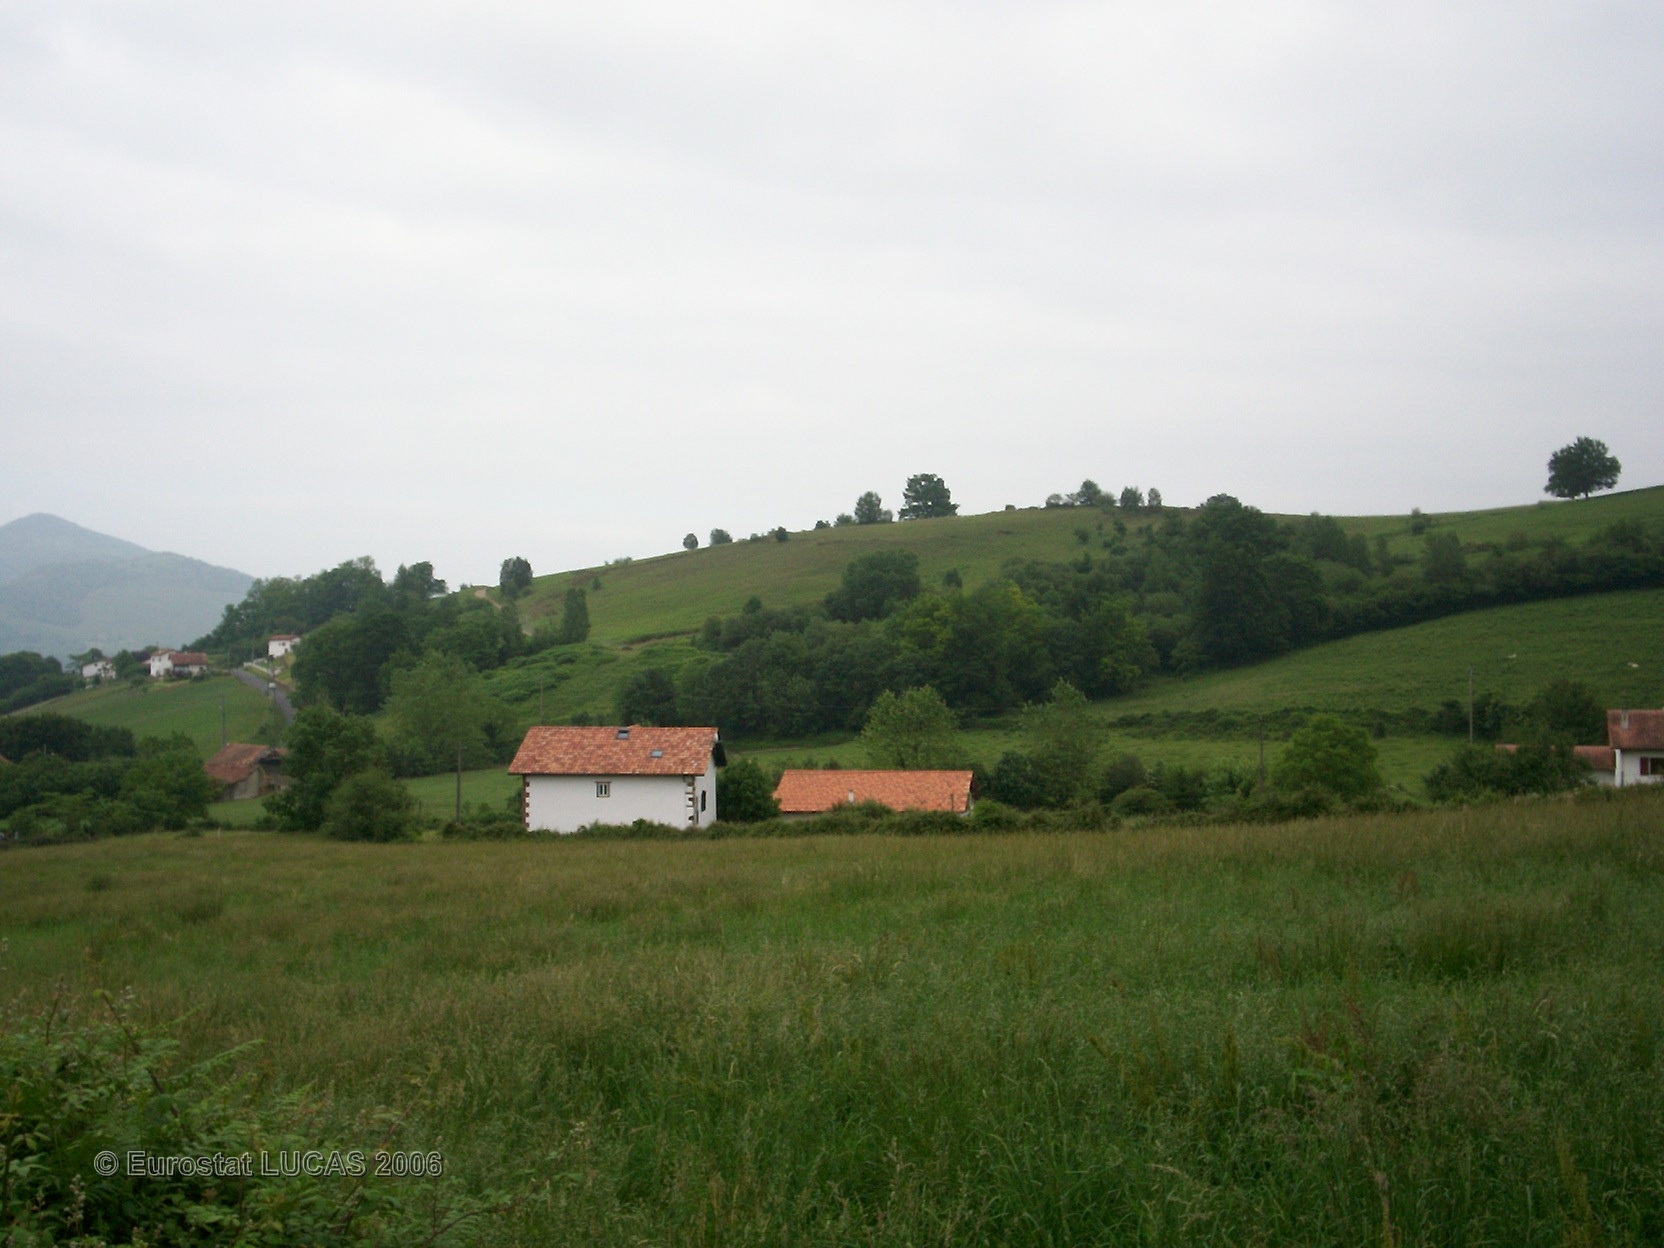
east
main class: Grassland
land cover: Grassland without tree/shrub cover
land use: Agriculture (excluding fallow land and kitchen gardens)
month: May
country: FR
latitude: 43.1677
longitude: -1.2933
